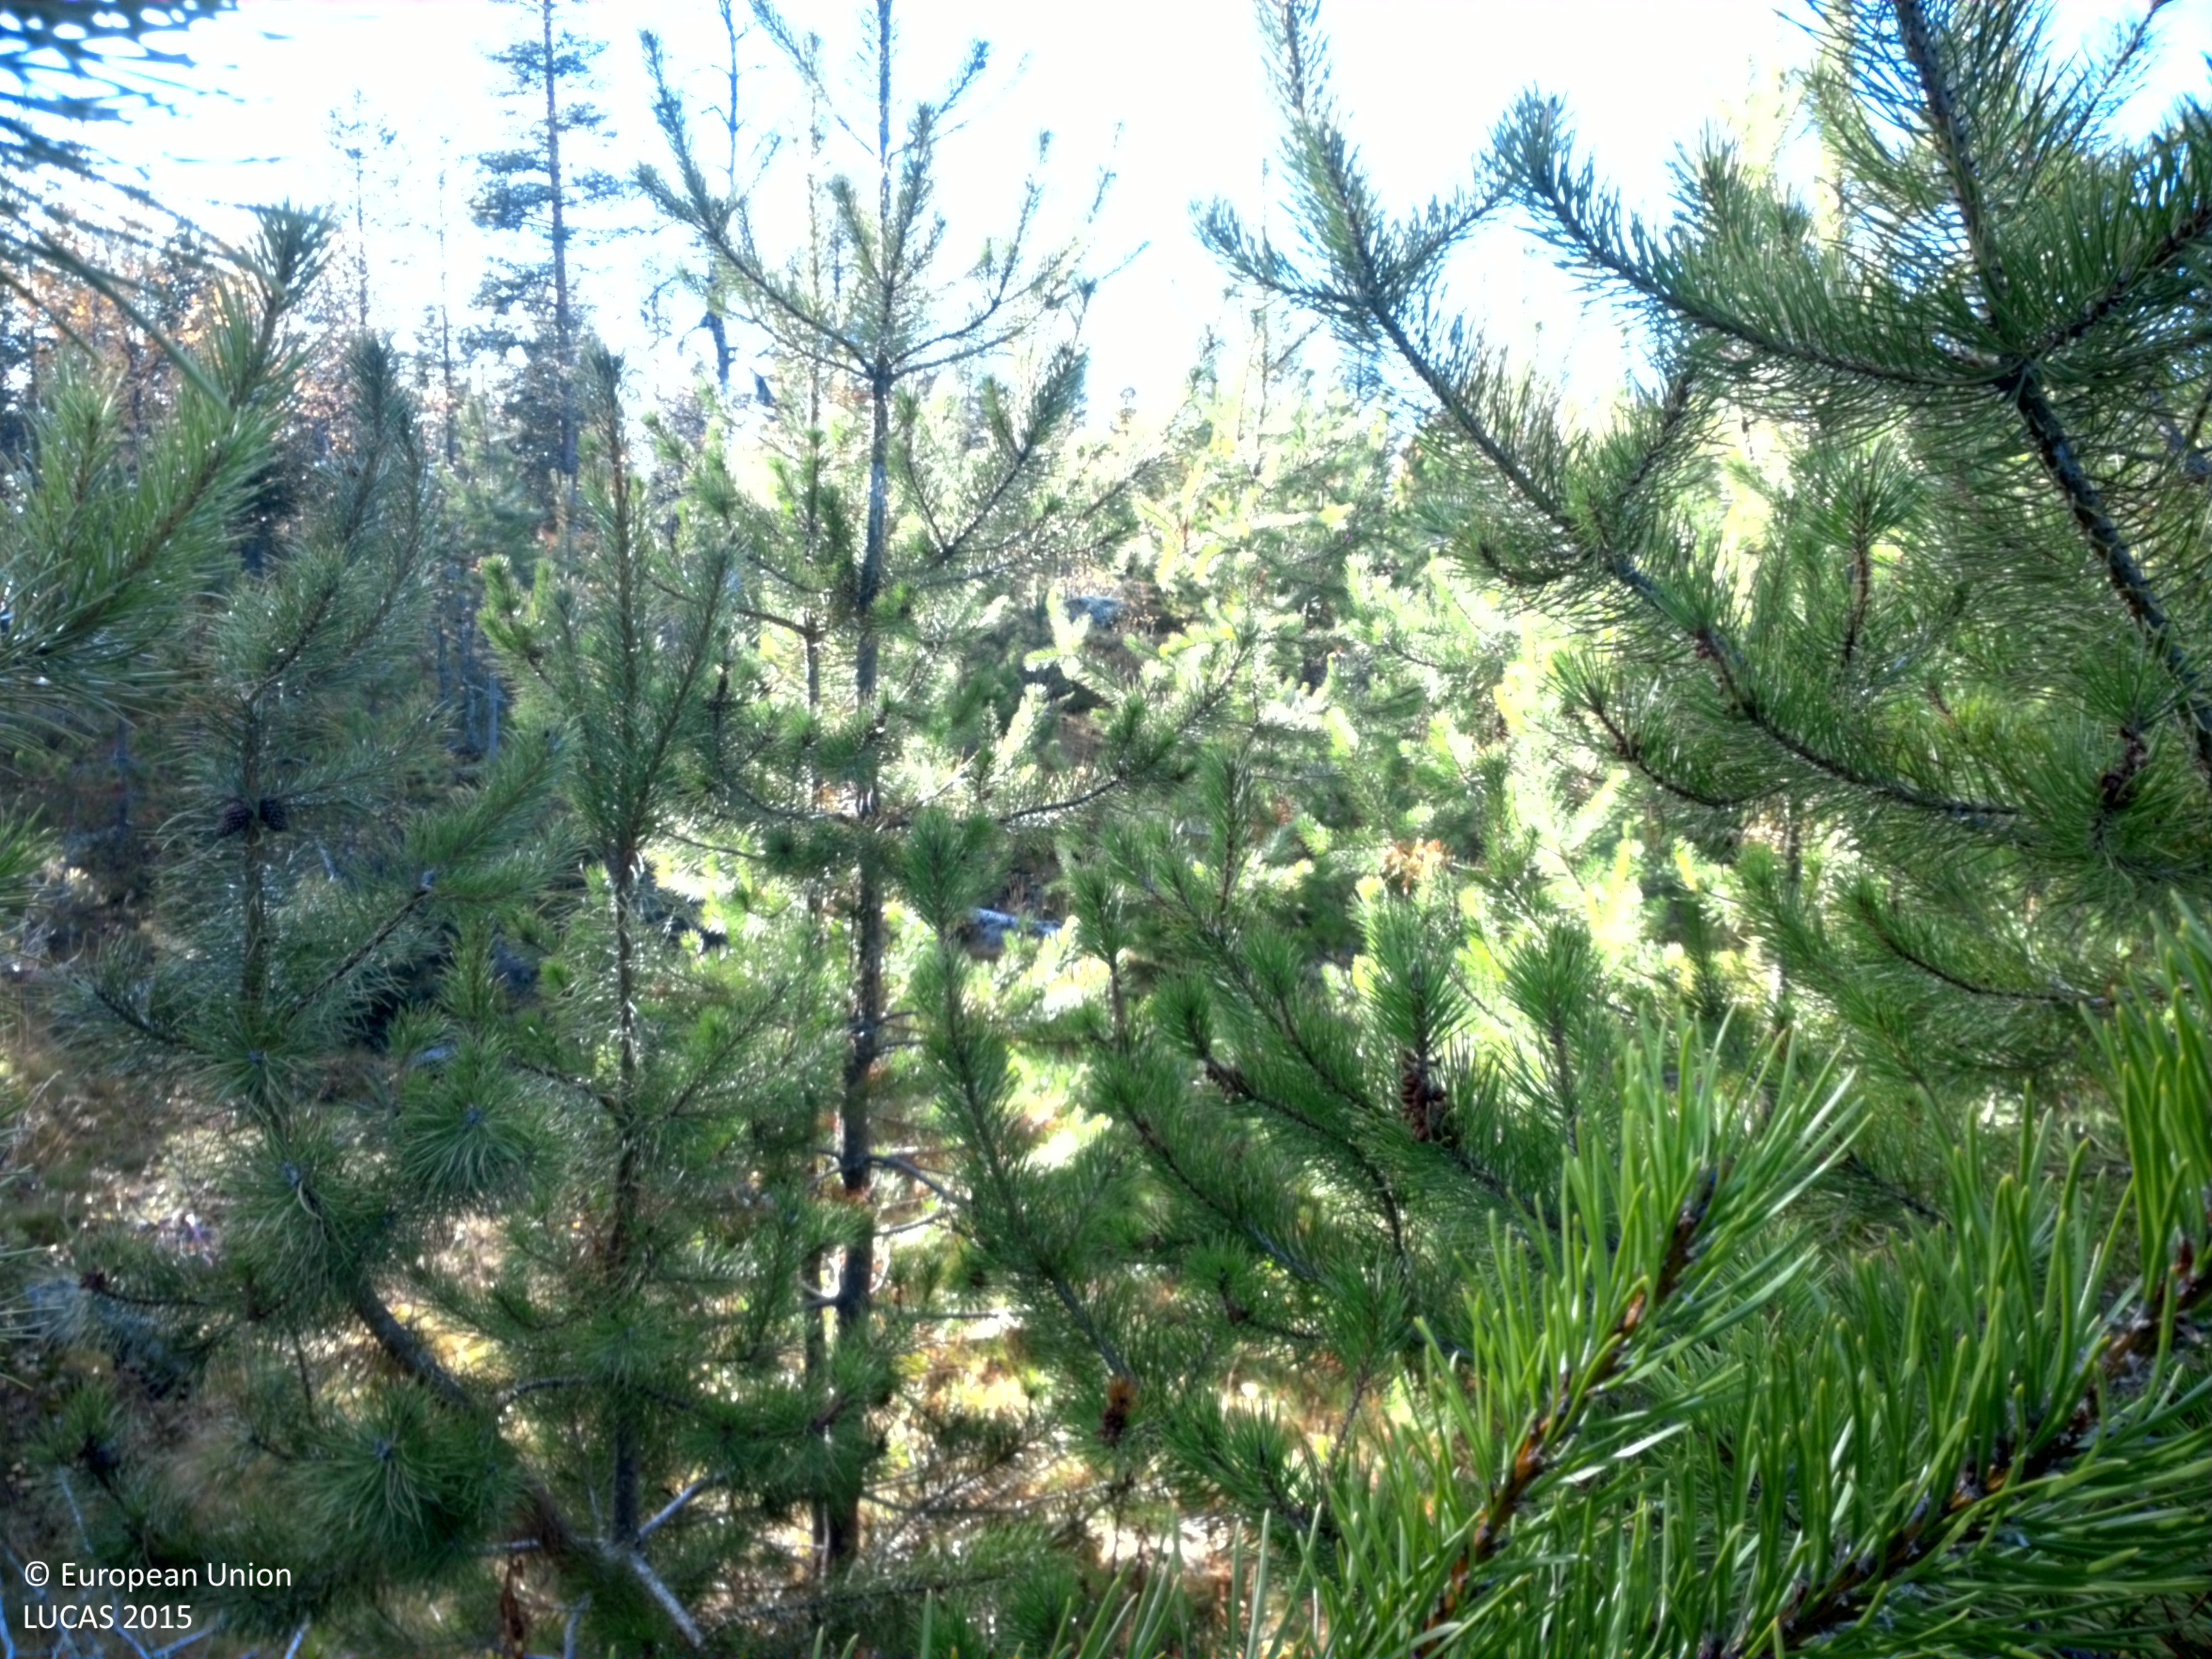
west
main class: Woodland
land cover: Pine dominated coniferous woodland
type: exotic forest
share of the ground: 25 - 50 %
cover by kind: coniferous forest trees 55 %, lichens and mosses 25 %, shrubs 10 %, herbaceous plants 10 %
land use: Forestry
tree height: < 5 m
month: September
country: SE
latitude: 64.8884
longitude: 17.5882
